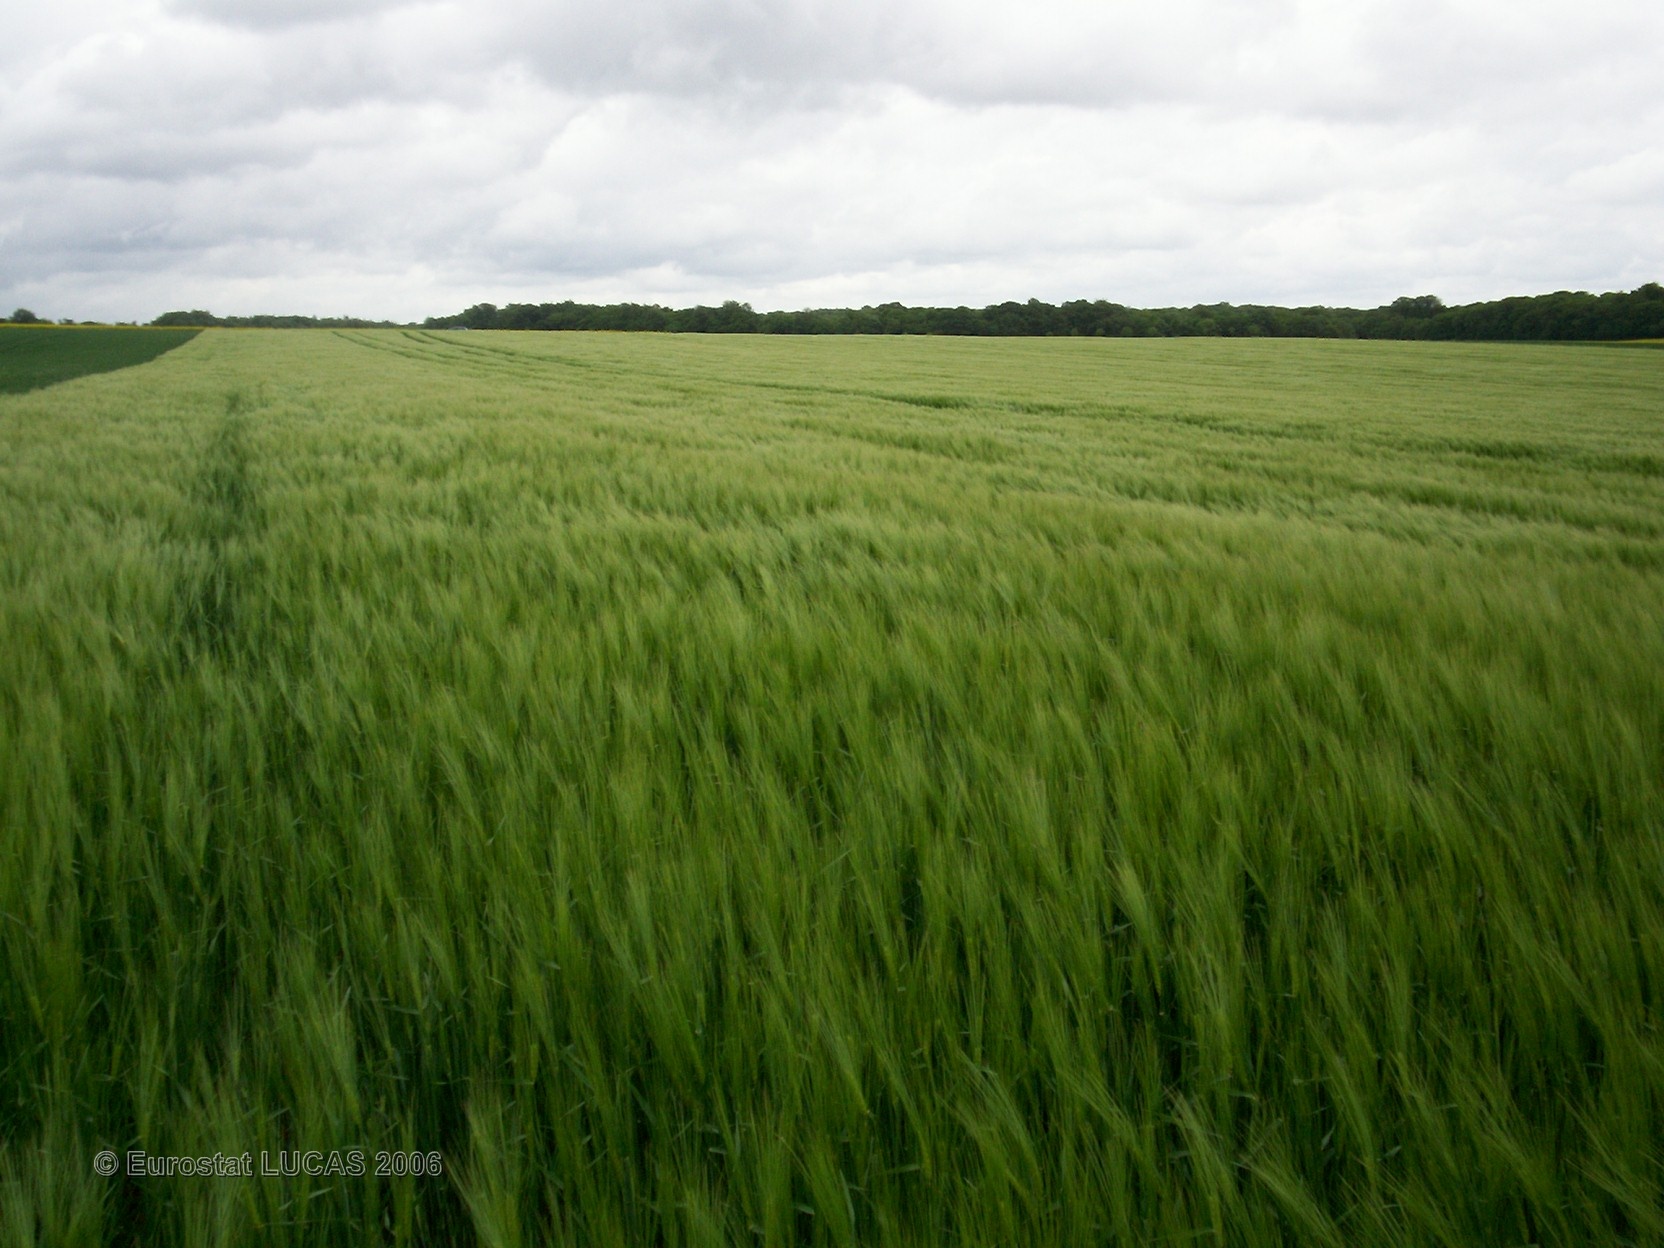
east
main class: Cropland
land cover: Barley
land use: Agriculture (excluding fallow land and kitchen gardens)
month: May
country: FR
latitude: 49.4244
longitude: 5.8493
